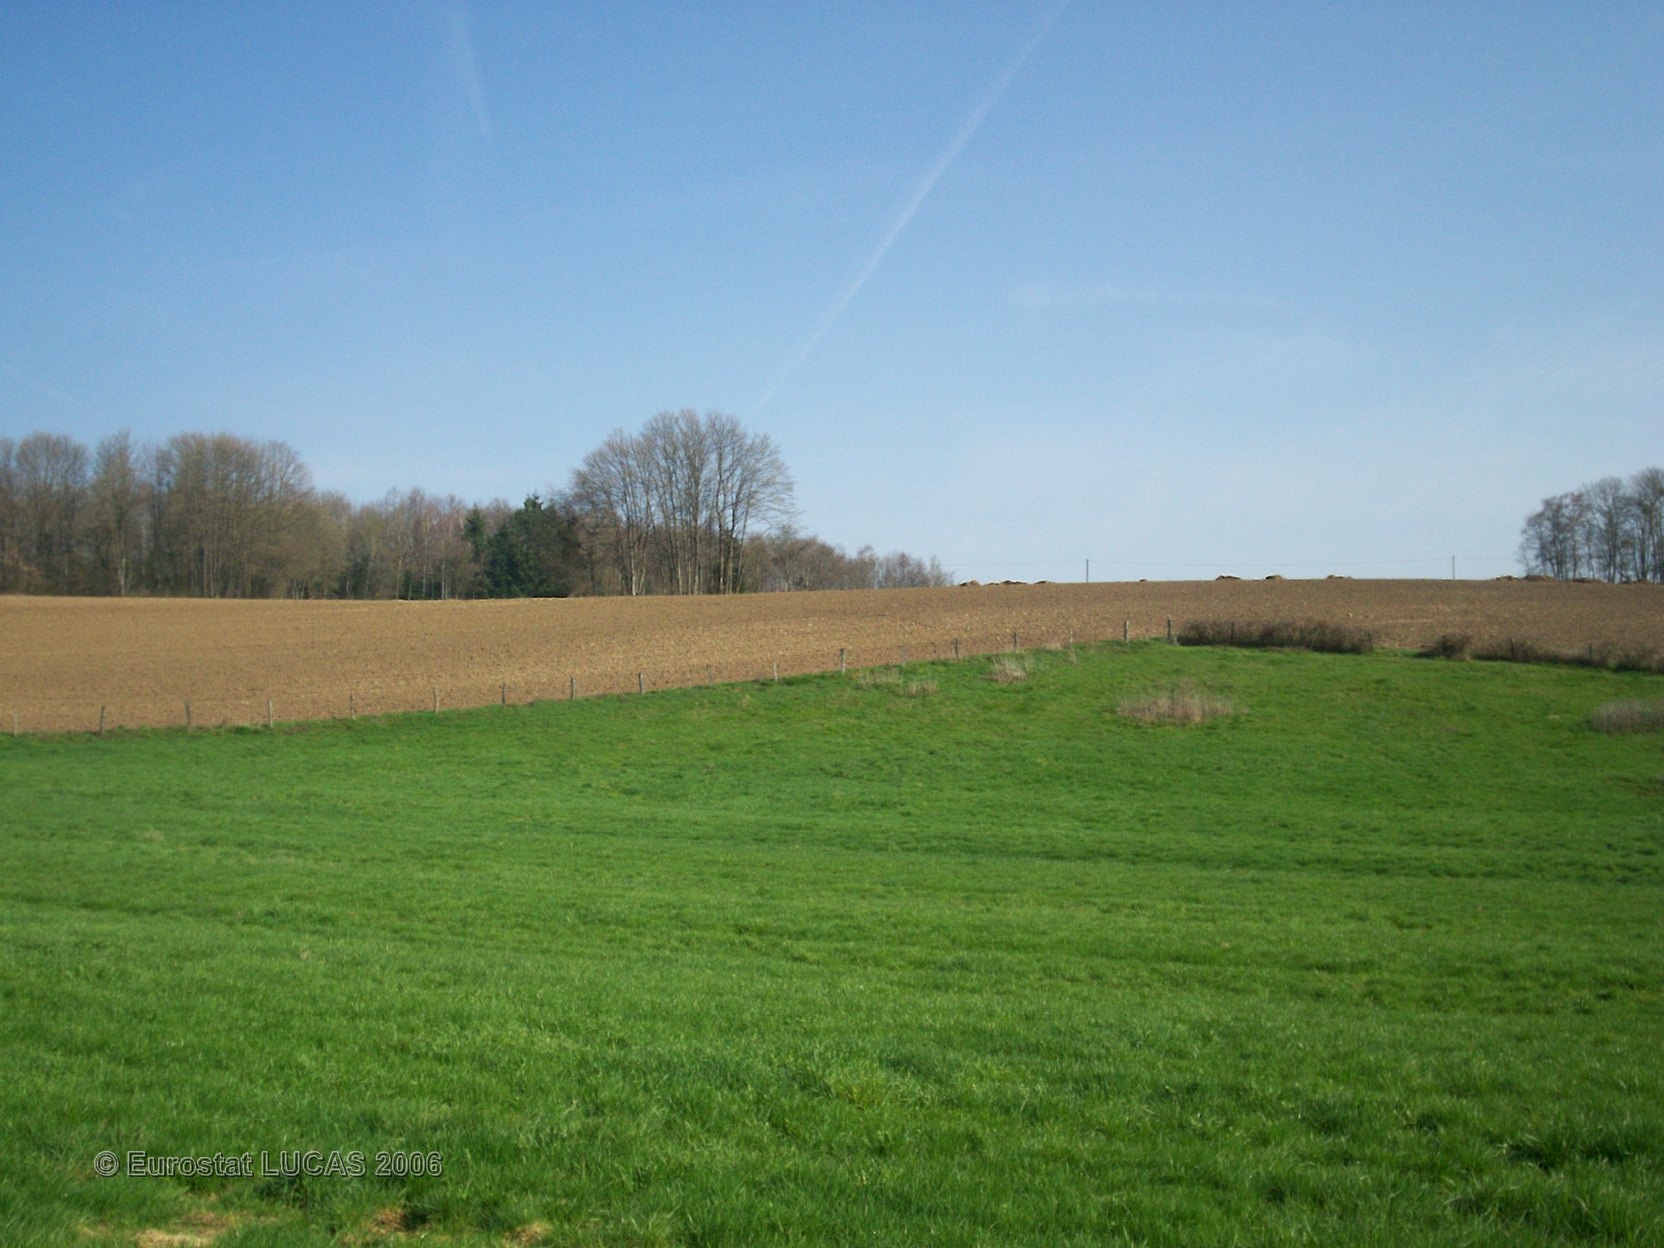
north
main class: Grassland
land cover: Grassland without tree/shrub cover
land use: Agriculture (excluding fallow land and kitchen gardens)
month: April
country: FR
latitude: 48.1625
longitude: 6.3302
